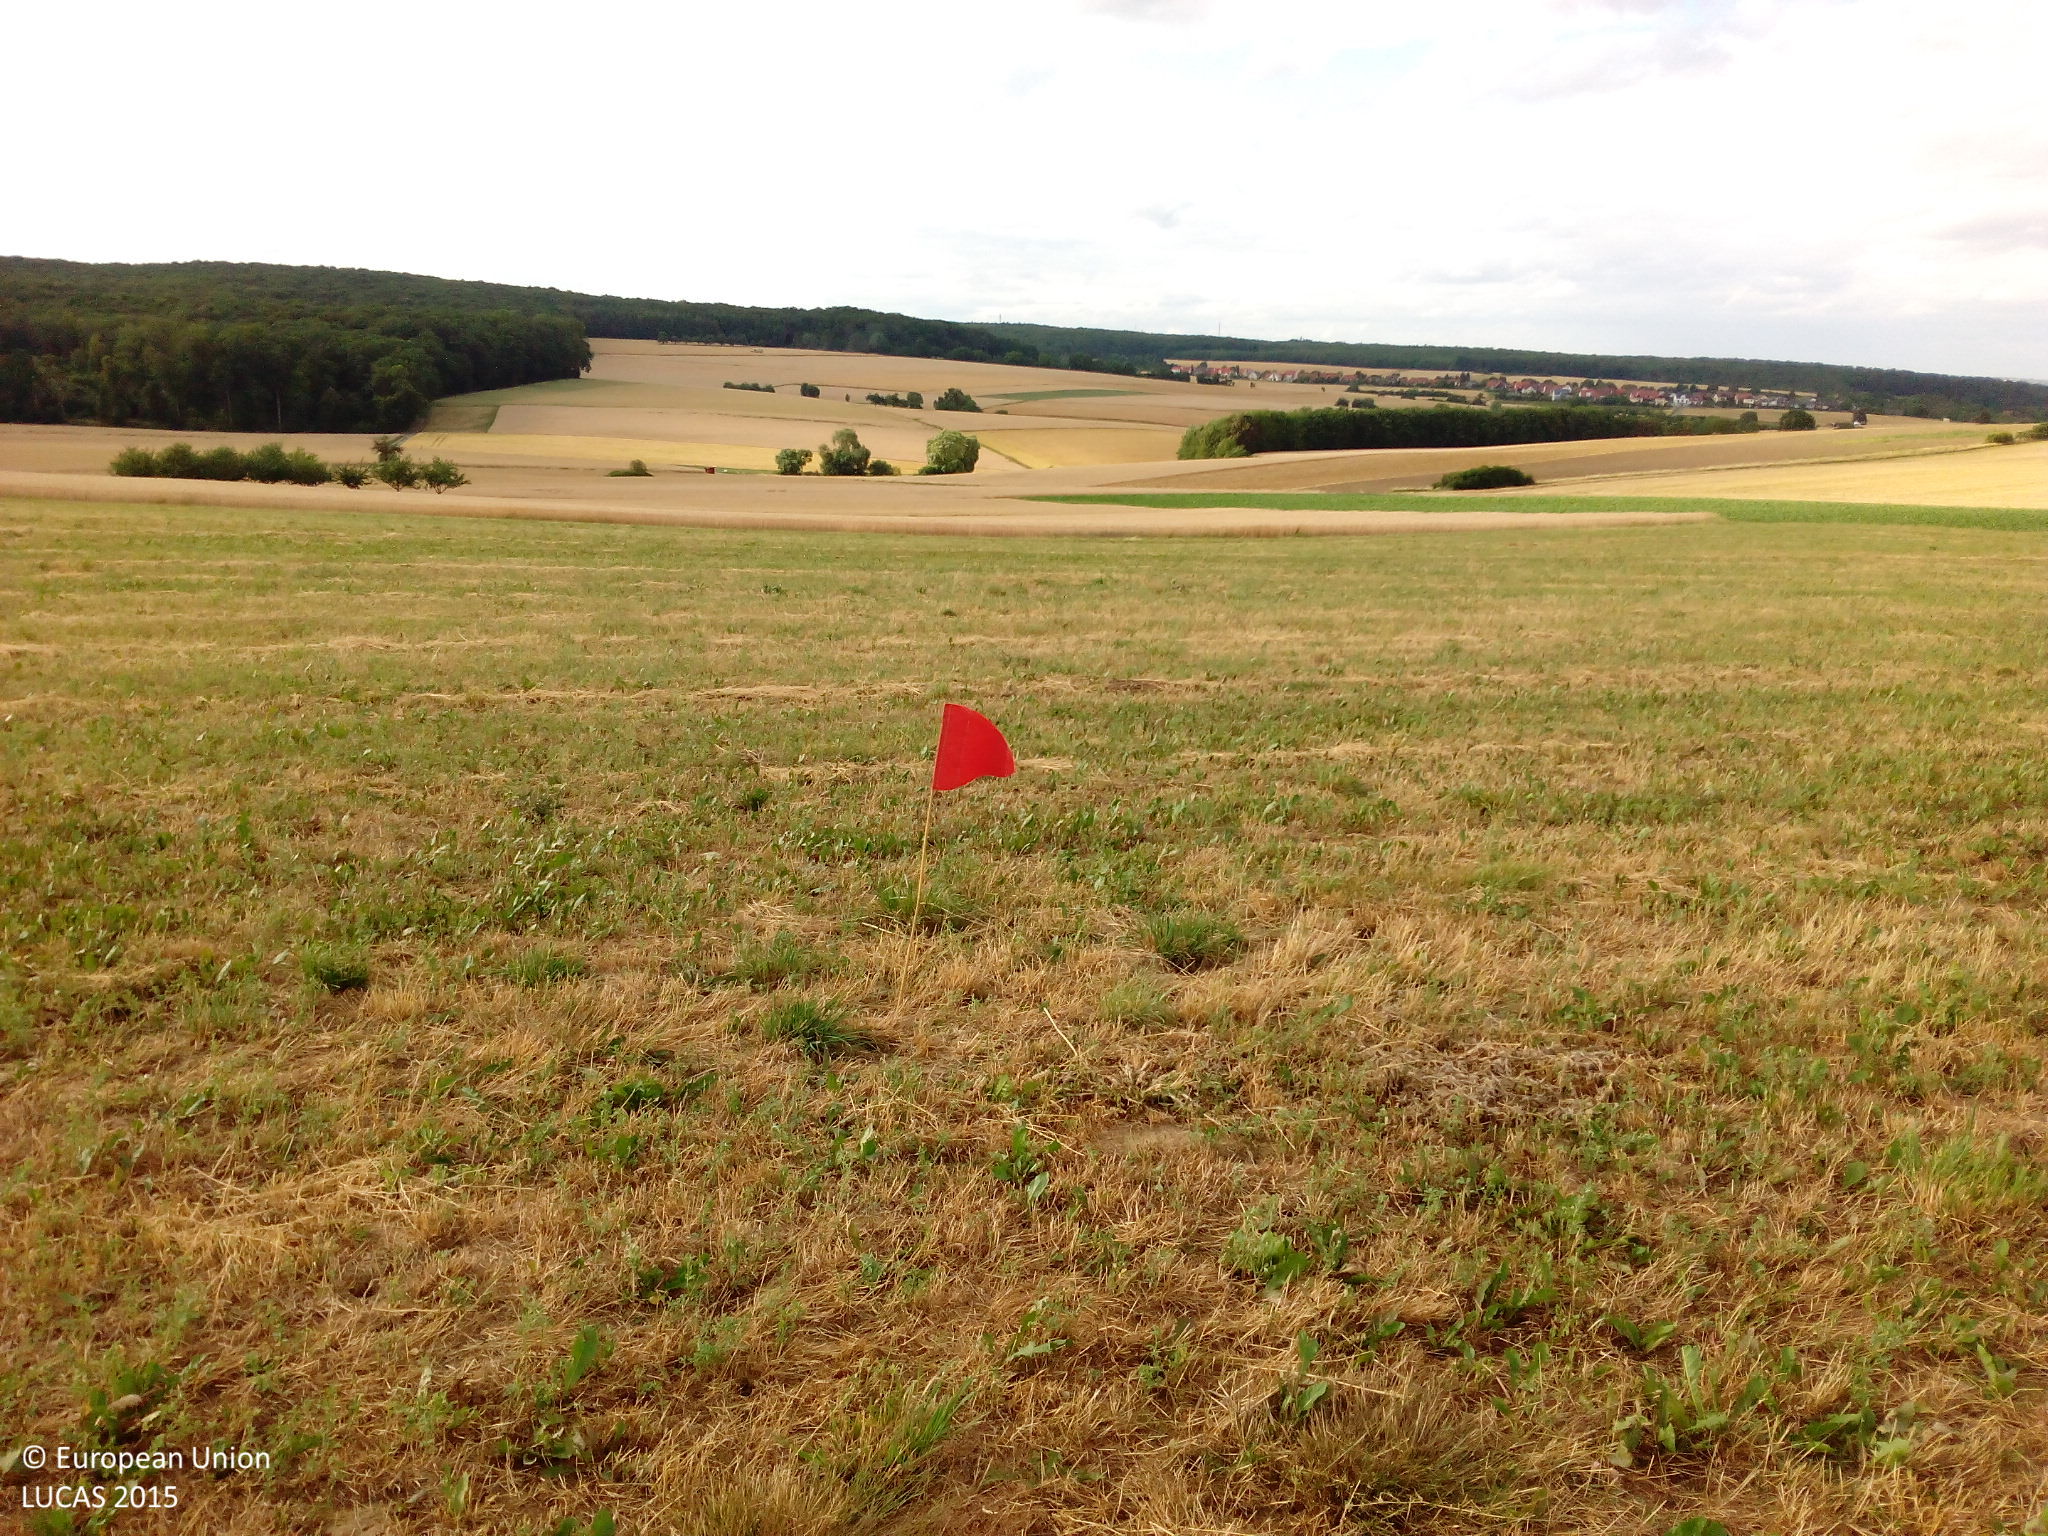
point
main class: Grassland
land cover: Grassland without tree/shrub cover
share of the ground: > 75 %
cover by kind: herbaceous plants 85 %, unconsolidated bare surface 15 %
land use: Agriculture (excluding fallow land and kitchen gardens)
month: July
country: DE
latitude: 49.7166
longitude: 9.9030
